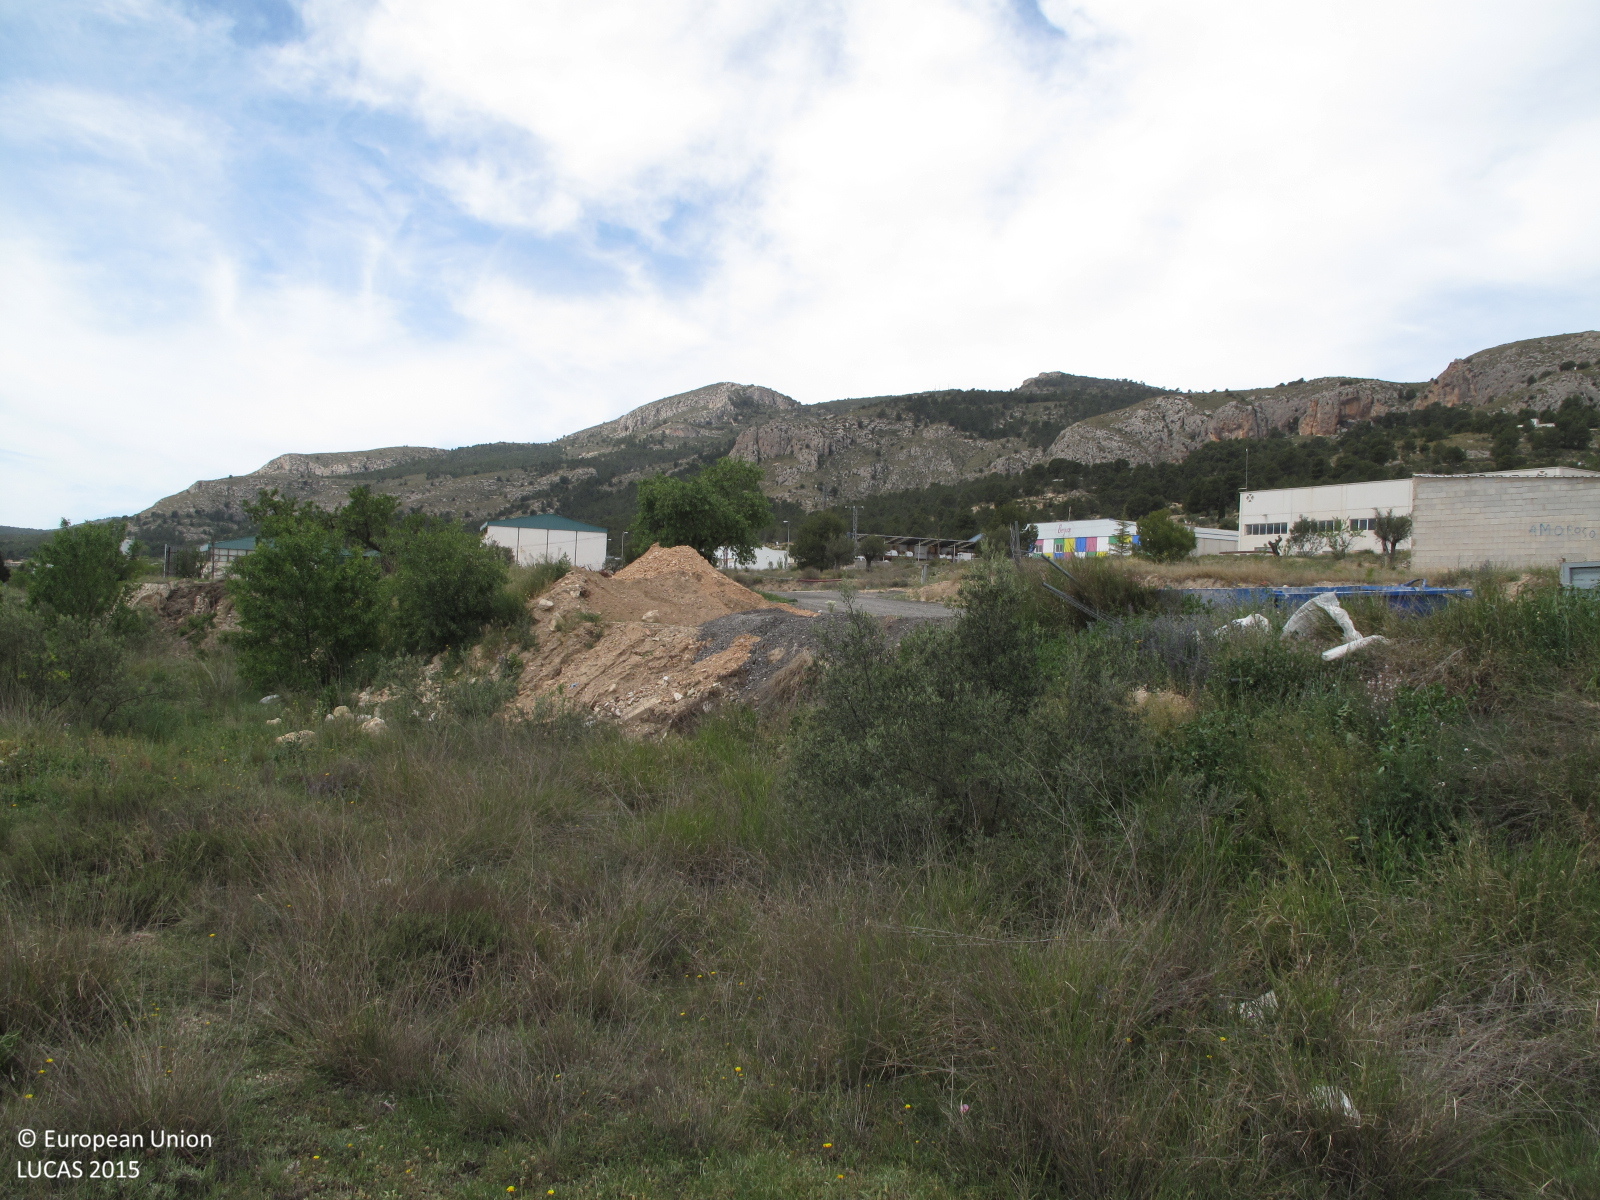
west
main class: Cropland
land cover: Olive groves
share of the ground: < 10 %
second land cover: Nuts trees
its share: < 10 %
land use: Agriculture (excluding fallow land and kitchen gardens)
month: April
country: ES
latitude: 38.6239
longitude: -0.6829
